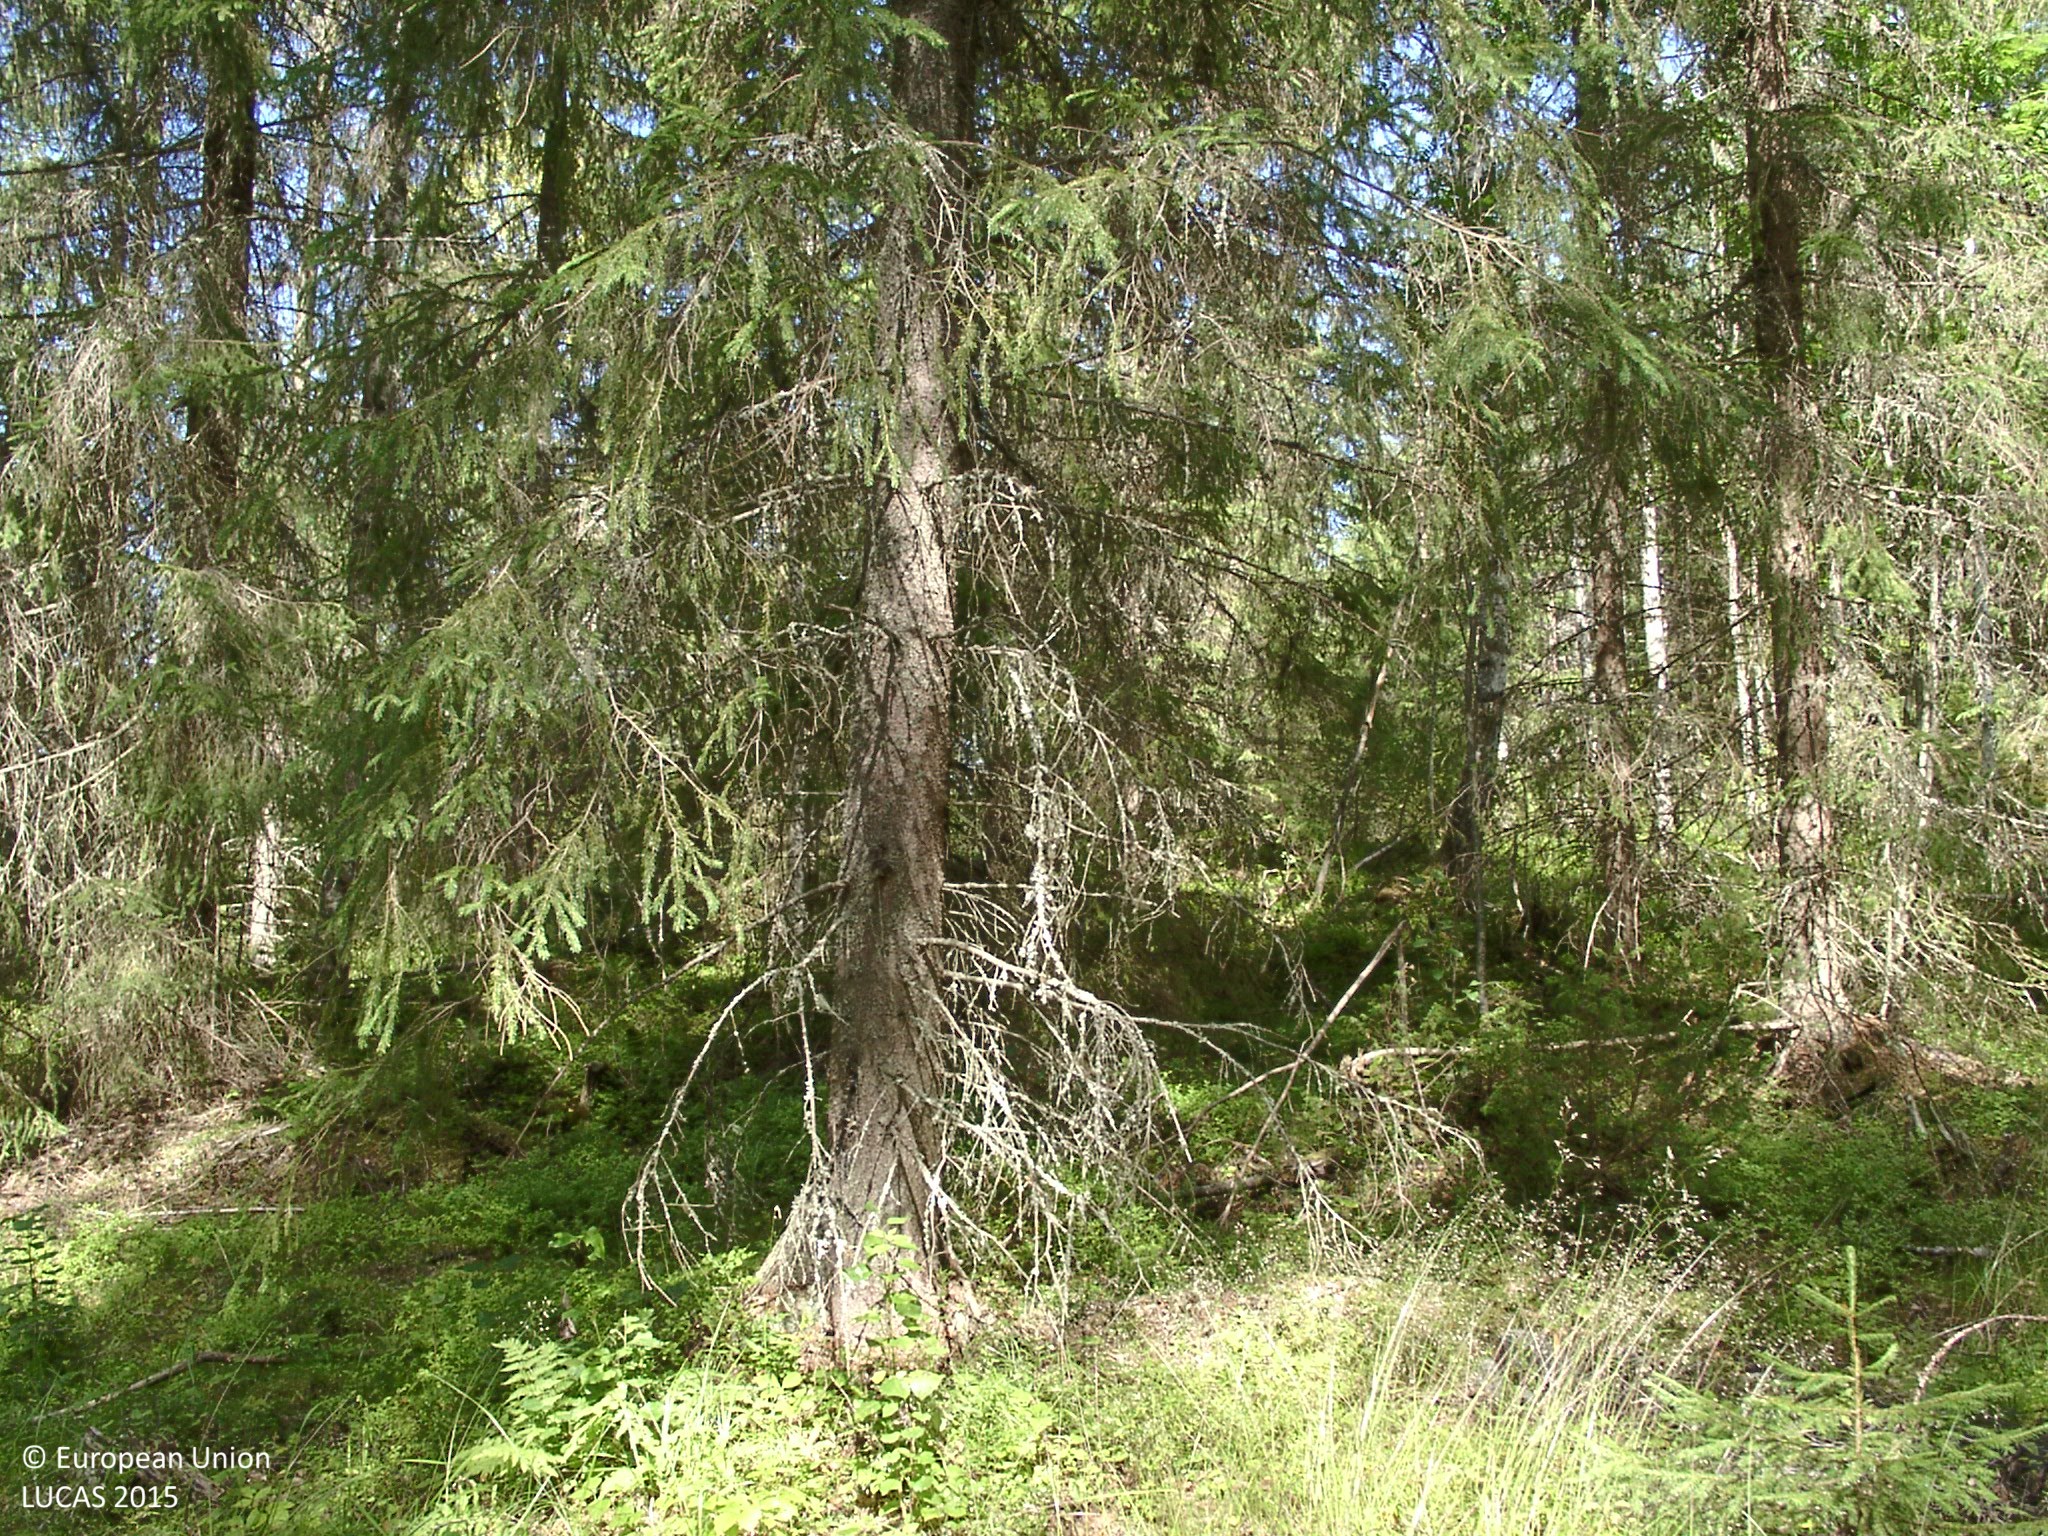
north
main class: Woodland
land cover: Spruce dominated mixed woodland
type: boreal forest
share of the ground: 50 - 75 %
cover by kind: coniferous forest trees 50 %, broadleaved forest trees 20 %, shrubs 15 %, lichens and mosses 10 %, herbaceous plants 5 %
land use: Forestry
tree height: > 5 m
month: August
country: FI
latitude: 62.9367
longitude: 25.0502
